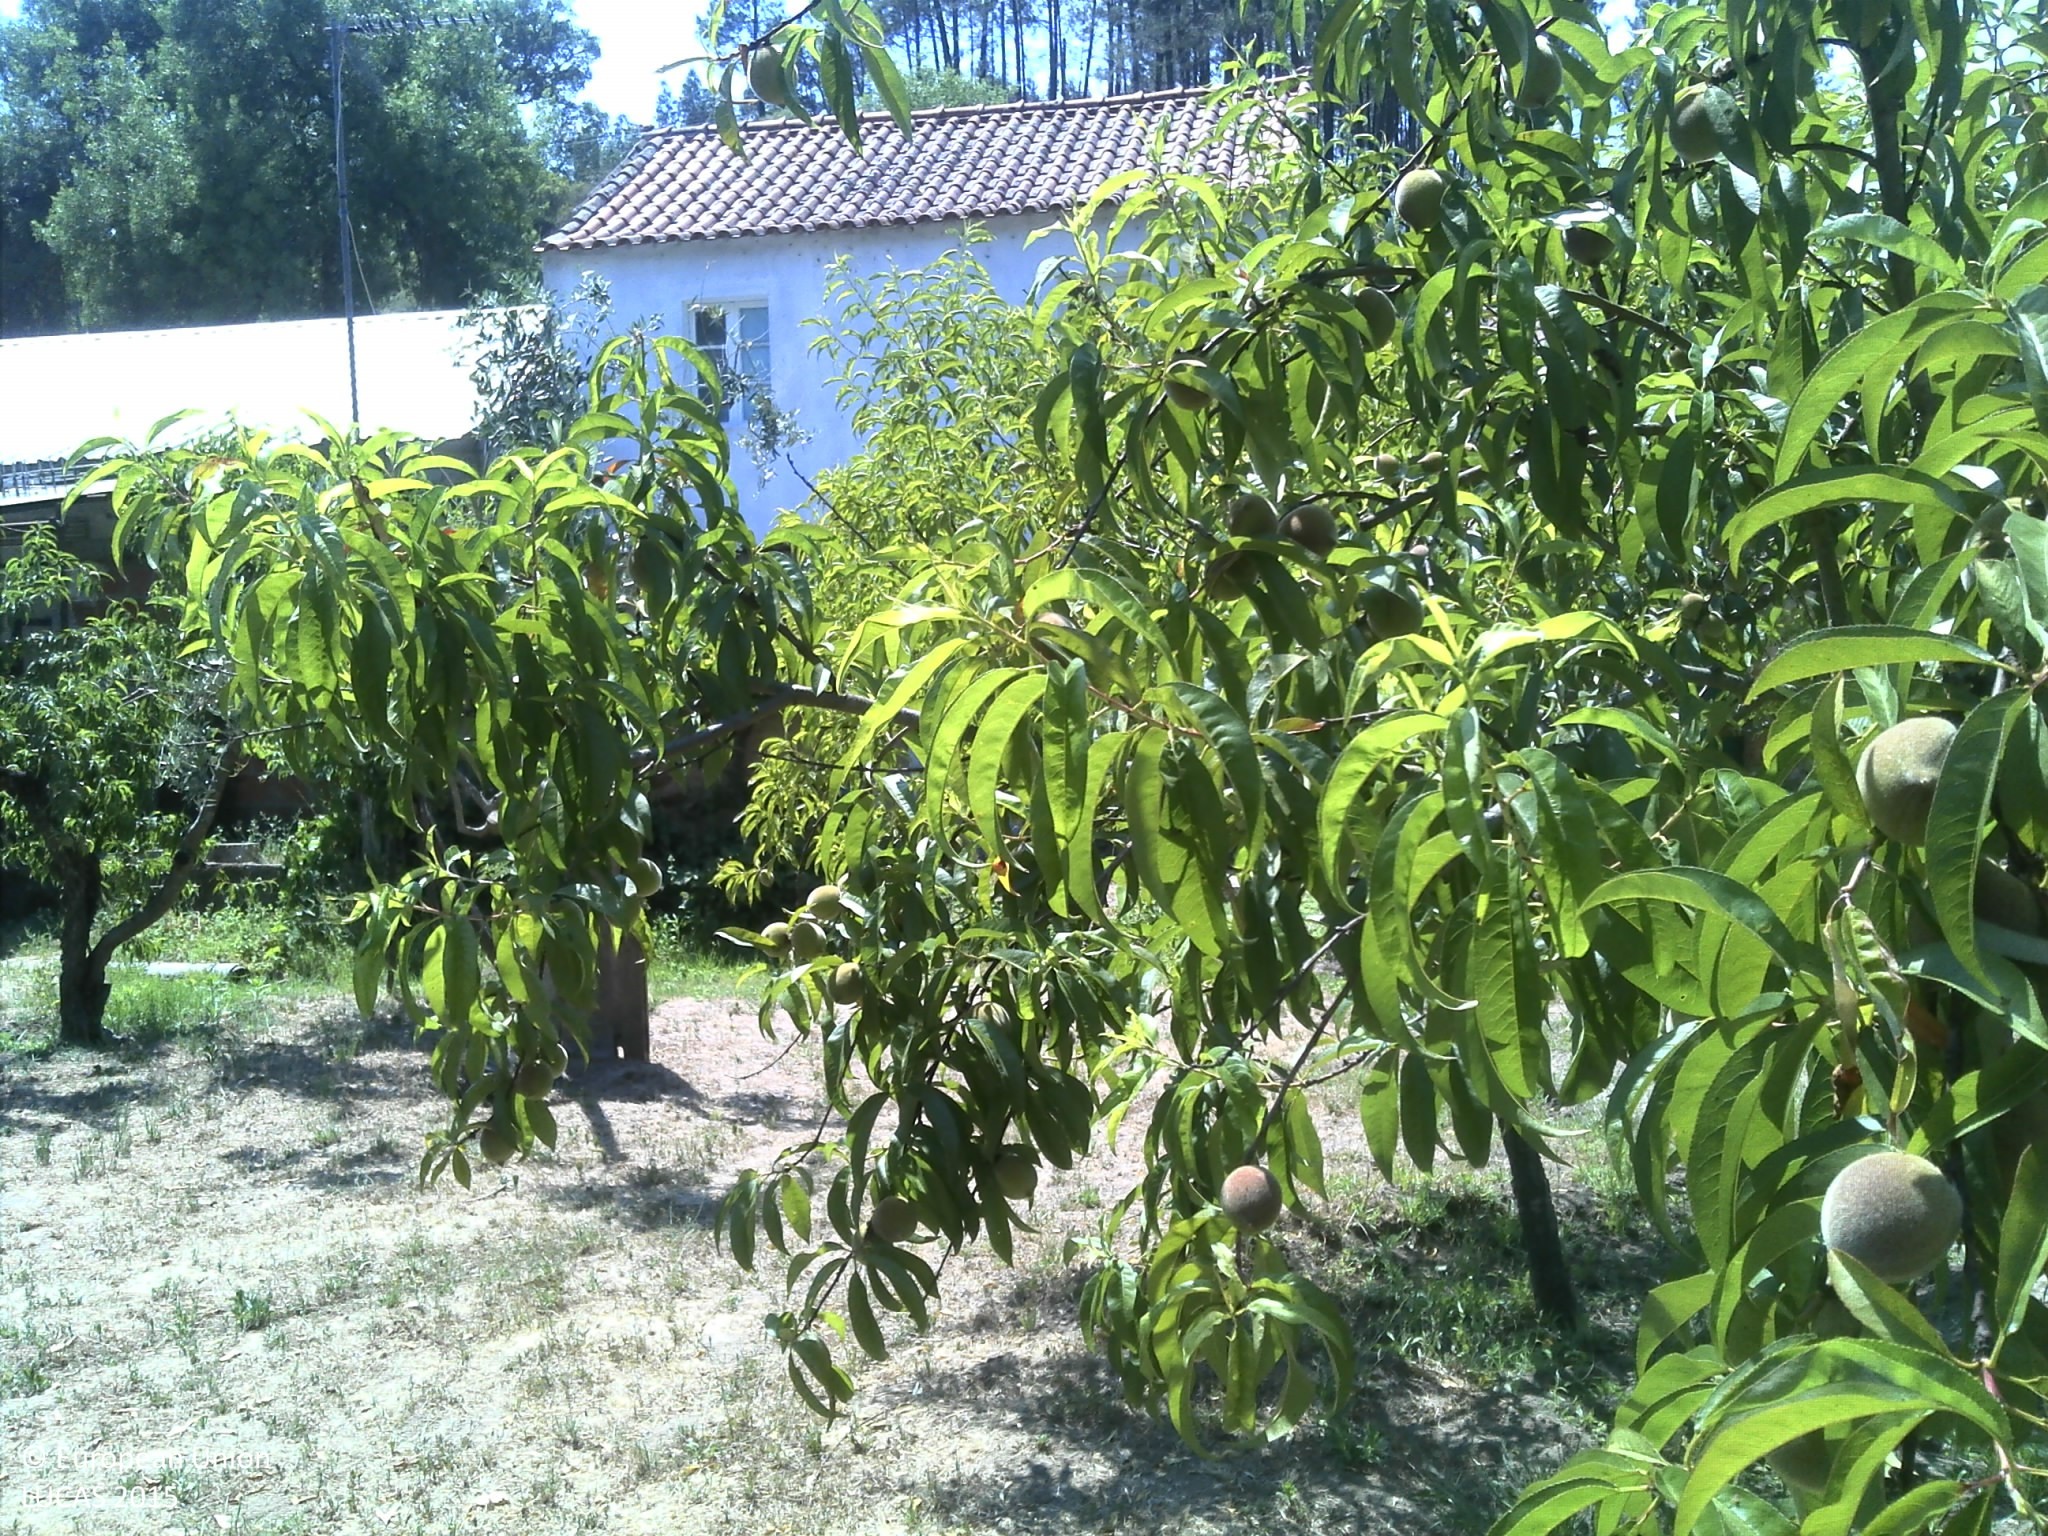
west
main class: Cropland
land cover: Other fruit trees and berries
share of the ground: 25 - 50 %
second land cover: Olive groves
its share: 25 - 50 %
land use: Agriculture (excluding fallow land and kitchen gardens)
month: June
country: PT
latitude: 39.4489
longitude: -8.0360
